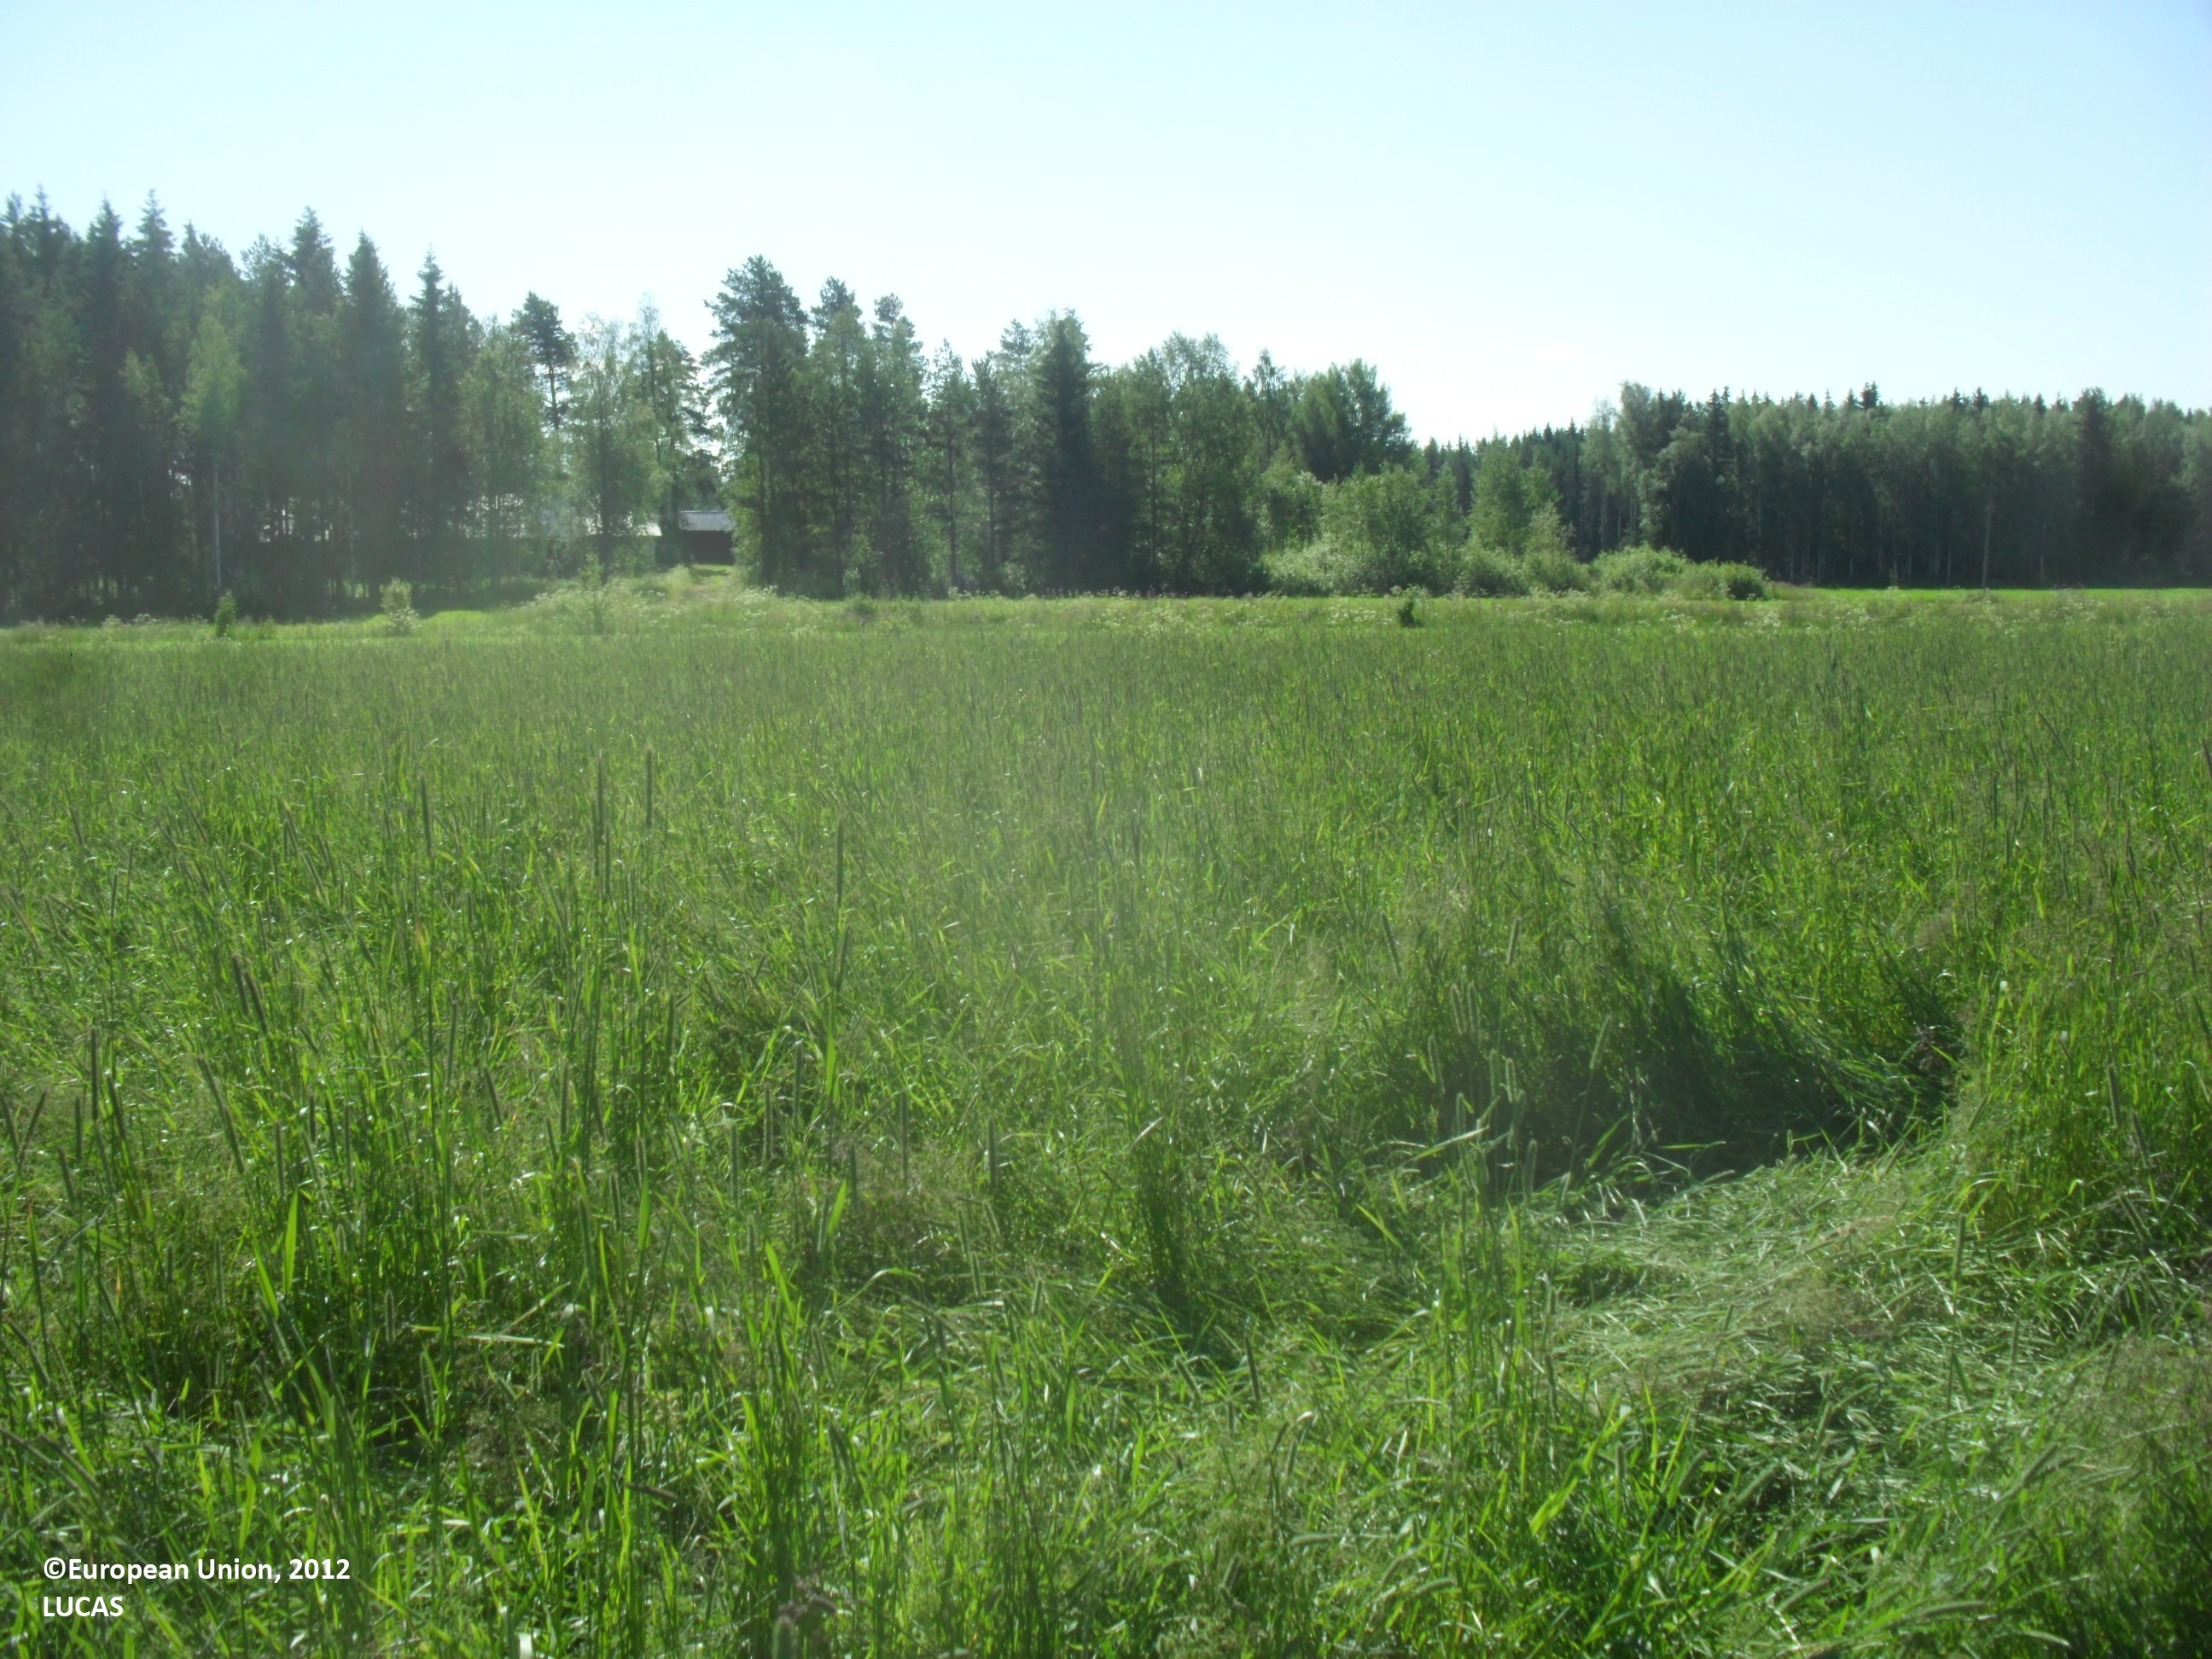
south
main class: Cropland
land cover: Temporary grasslands
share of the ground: > 75 %
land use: Agriculture (excluding fallow land and kitchen gardens)
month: July
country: FI
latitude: 63.1814
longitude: 23.8386
